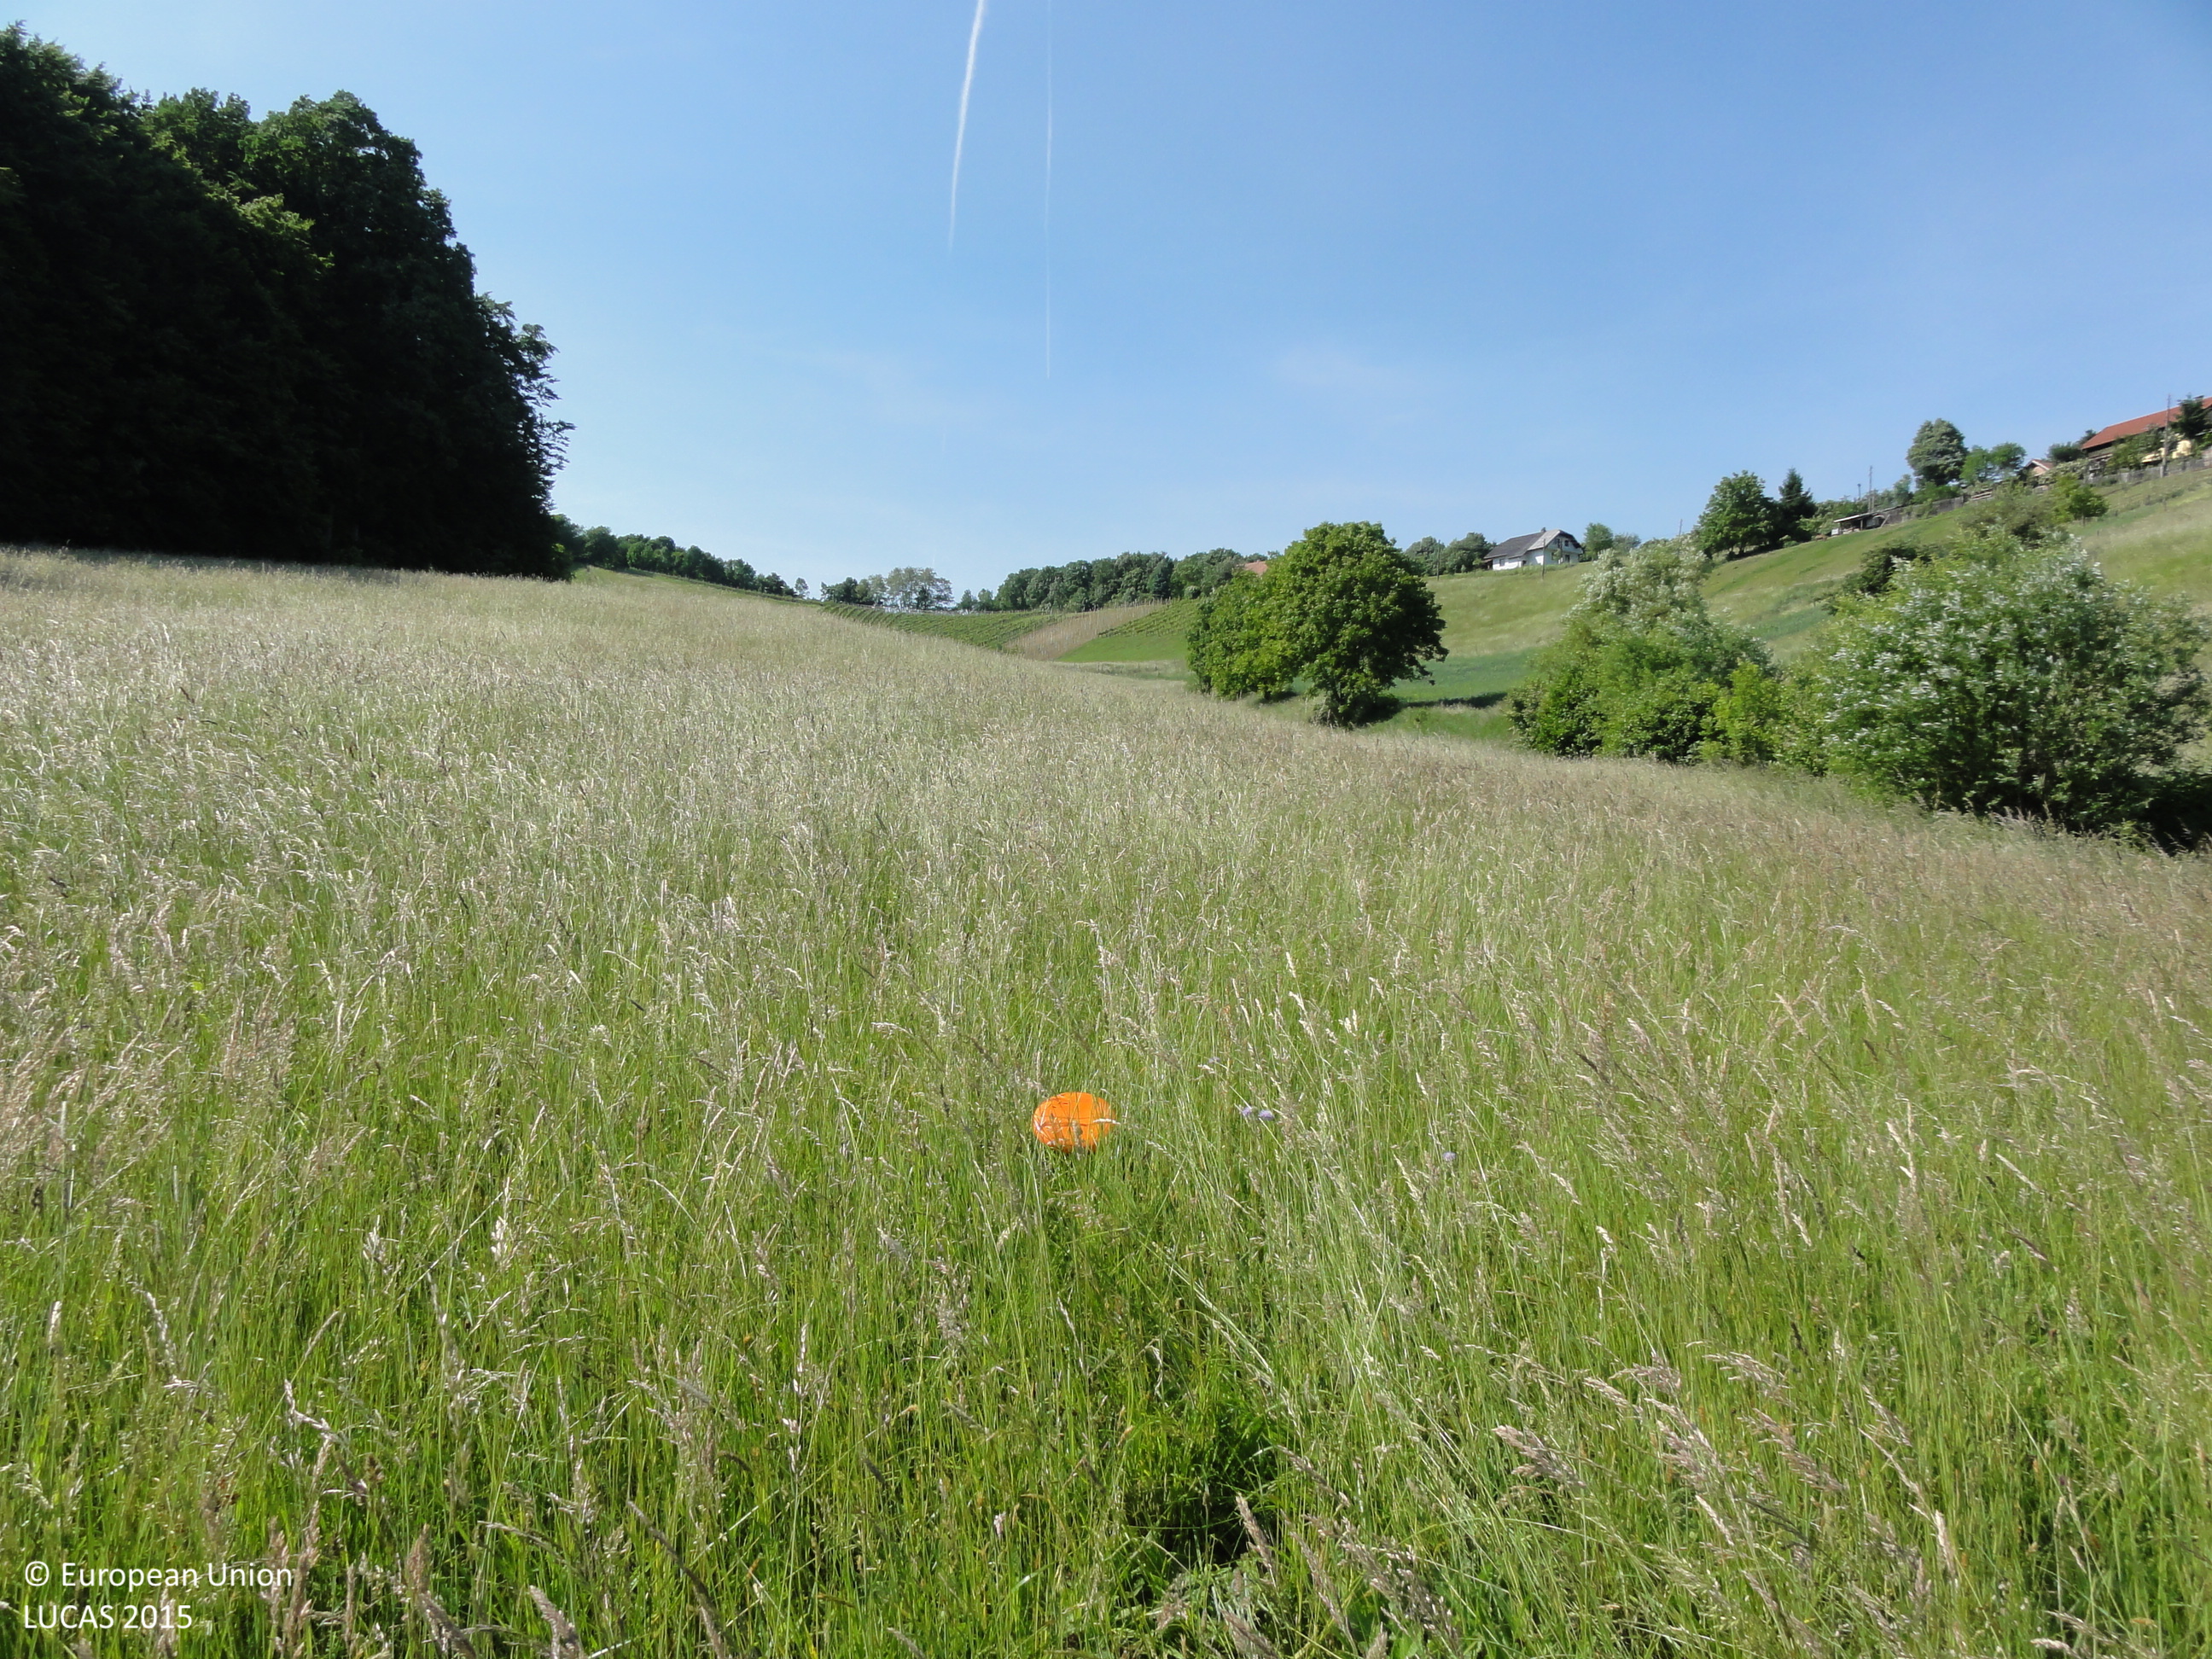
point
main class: Grassland
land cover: Grassland without tree/shrub cover
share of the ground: > 75 %
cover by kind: herbaceous plants 100 %
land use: Agriculture (excluding fallow land and kitchen gardens)
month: May
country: SI
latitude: 46.6128
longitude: 15.7316
